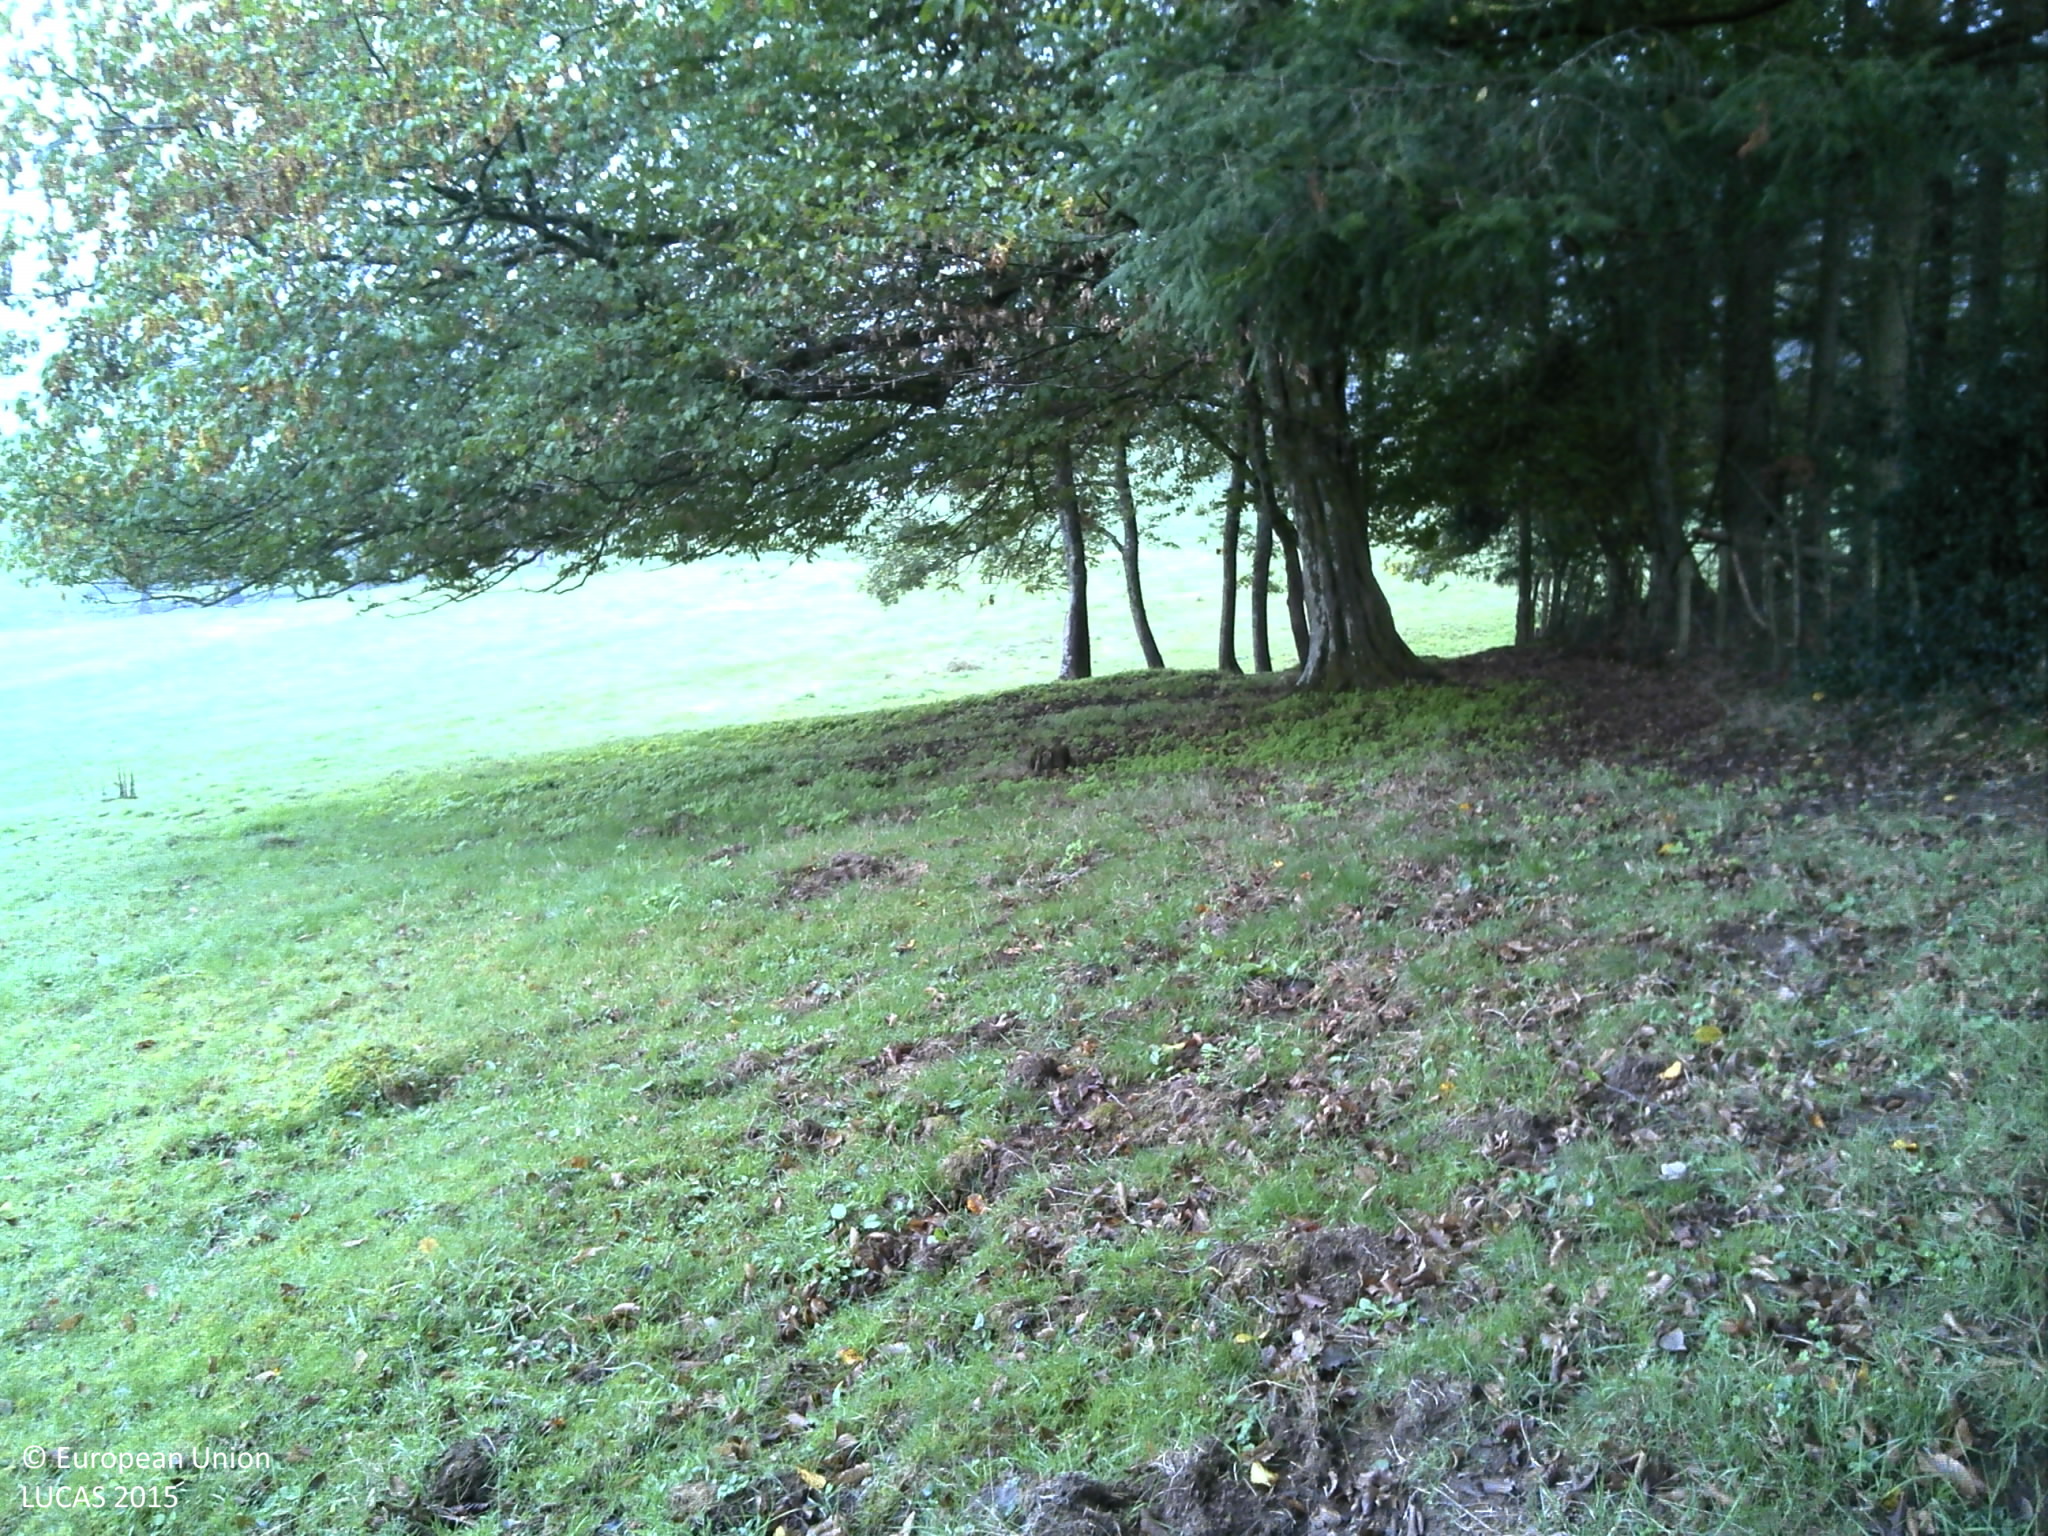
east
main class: Woodland
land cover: Broadleaved woodland
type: mesophytic deciduous forest
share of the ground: 25 - 50 %
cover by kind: broadleaved forest trees 50 %, herbaceous plants 35 %
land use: Forestry
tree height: > 5 m
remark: Clear cut
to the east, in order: Broadleaved woodland; Spruce dominated mixed woodland; Fences; Grassland without tree/shrub cover; Fences; Grassland with sparse tree/shrub cover; Ditches and canals; Grassland with sparse tree/shrub cover; Grassland without tree/shrub cover
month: October
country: FR
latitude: 46.3351
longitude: 4.4805
